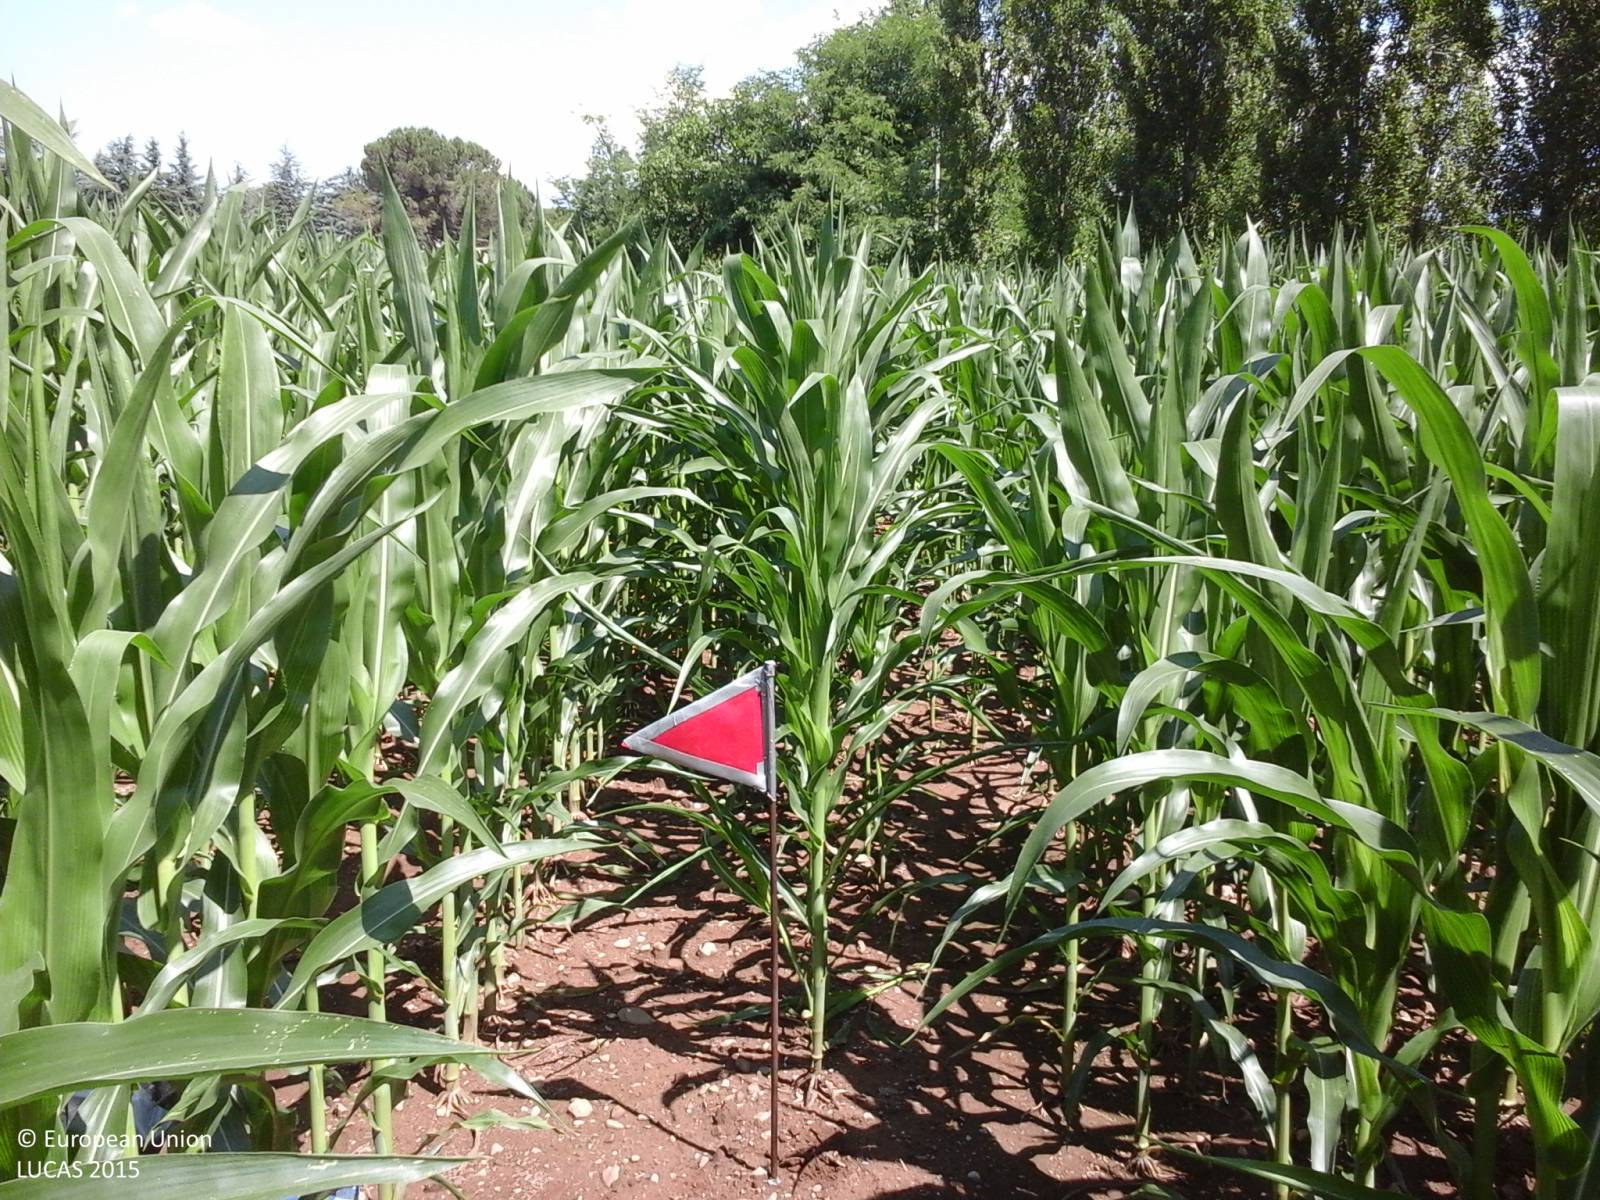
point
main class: Cropland
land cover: Maize
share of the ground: > 75 %
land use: Agriculture (excluding fallow land and kitchen gardens)
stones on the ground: < 10 %
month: June
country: IT
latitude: 46.1405
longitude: 13.2199
